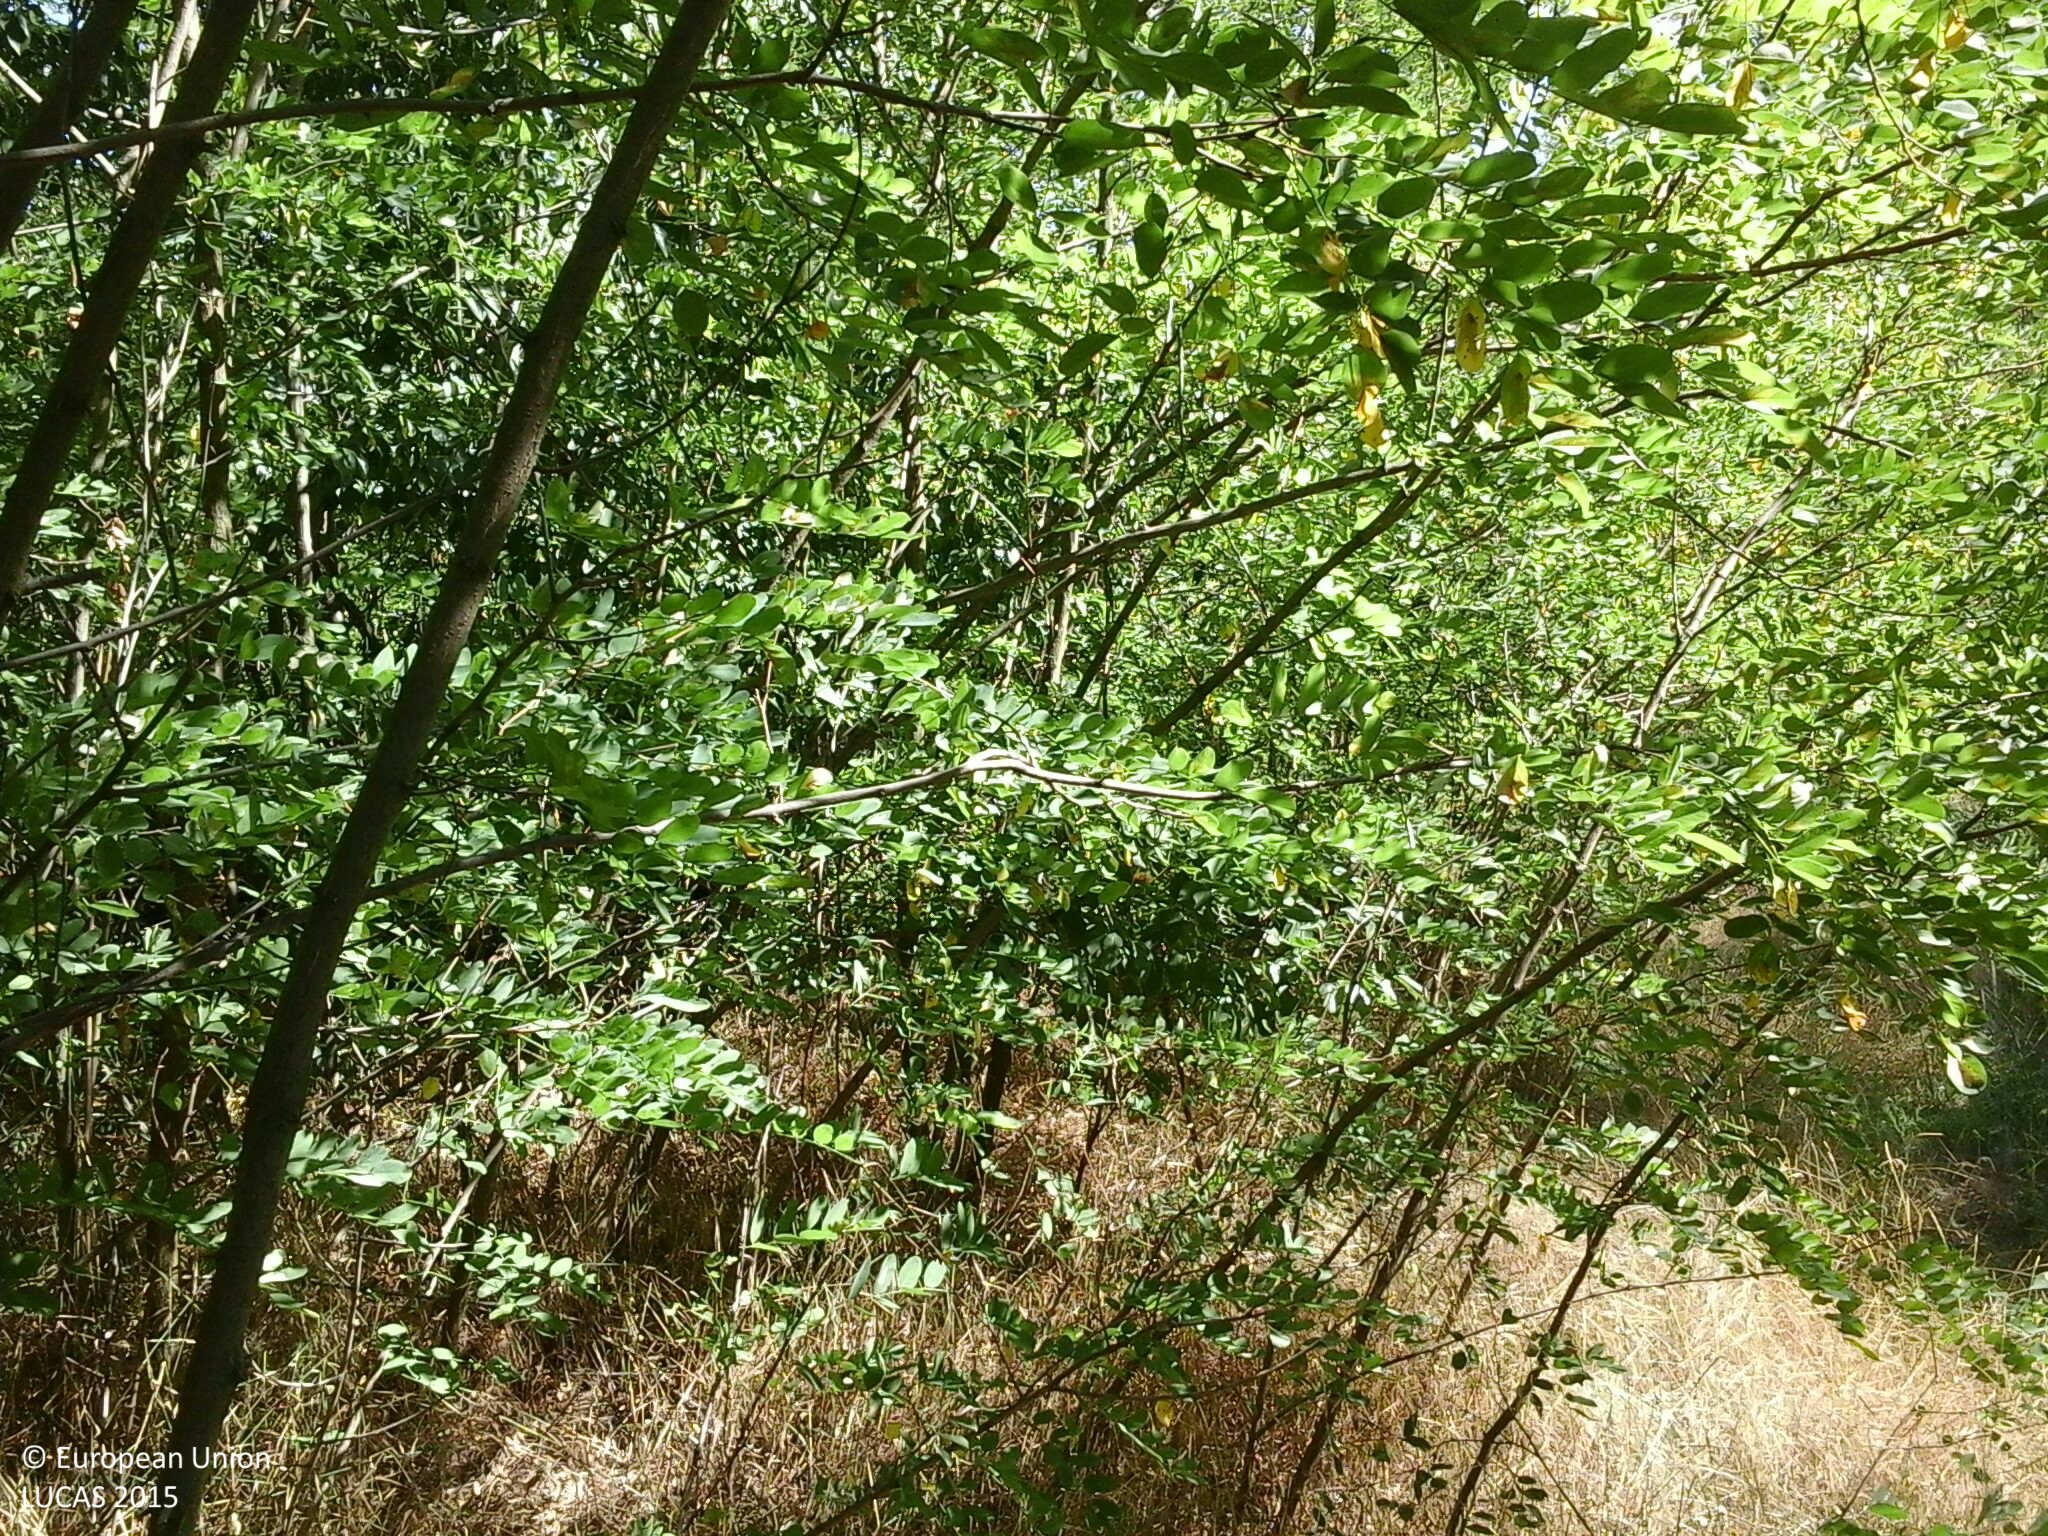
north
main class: Woodland
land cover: Broadleaved woodland
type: exotic forest
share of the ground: > 75 %
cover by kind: broadleaved forest trees 95 %, herbaceous plants 5 %
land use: Forestry
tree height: > 5 m
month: July
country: HU
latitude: 47.6365
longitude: 22.1779
